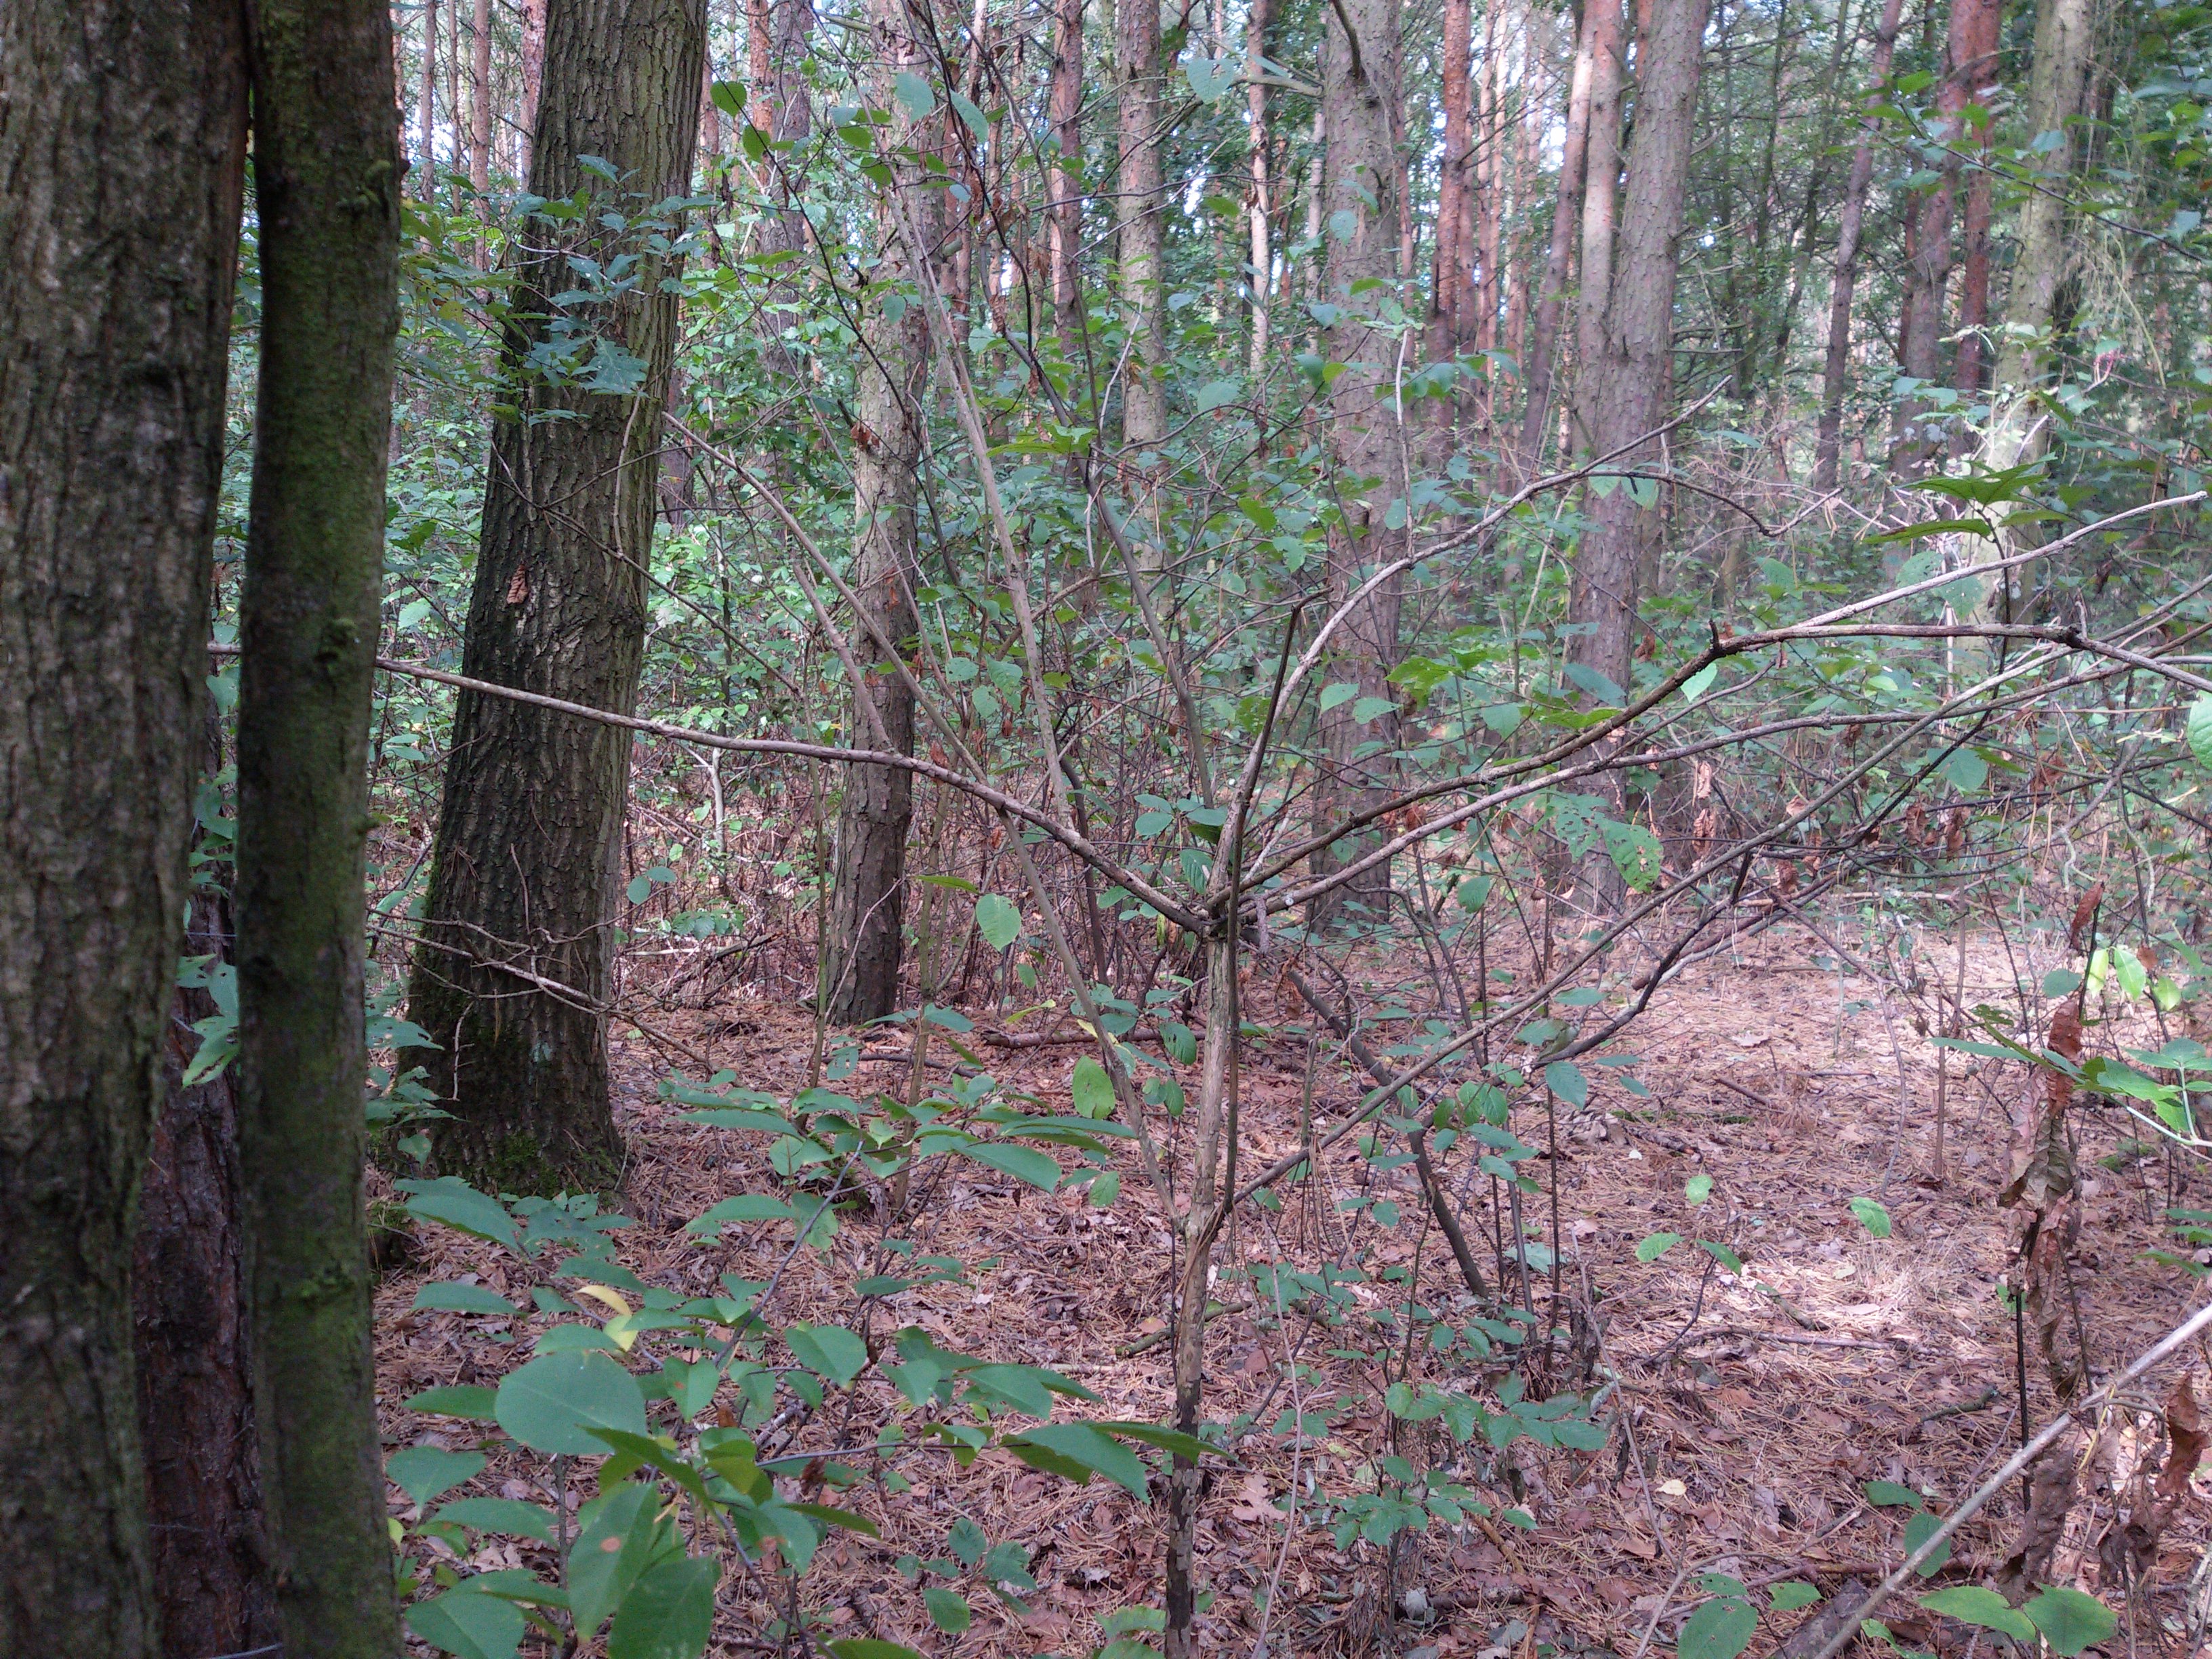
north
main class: Woodland
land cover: Pine dominated mixed woodland
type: hemiboreal forest and nemoral coniferous forest and mixed broadleaved-coniferous forest
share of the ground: > 75 %
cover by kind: coniferous forest trees 60 %, broadleaved forest trees 25 %, shrubs 10 %, unconsolidated bare surface 5 %
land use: Forestry
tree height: > 5 m
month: September
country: PL
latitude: 53.1219
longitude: 17.6787
